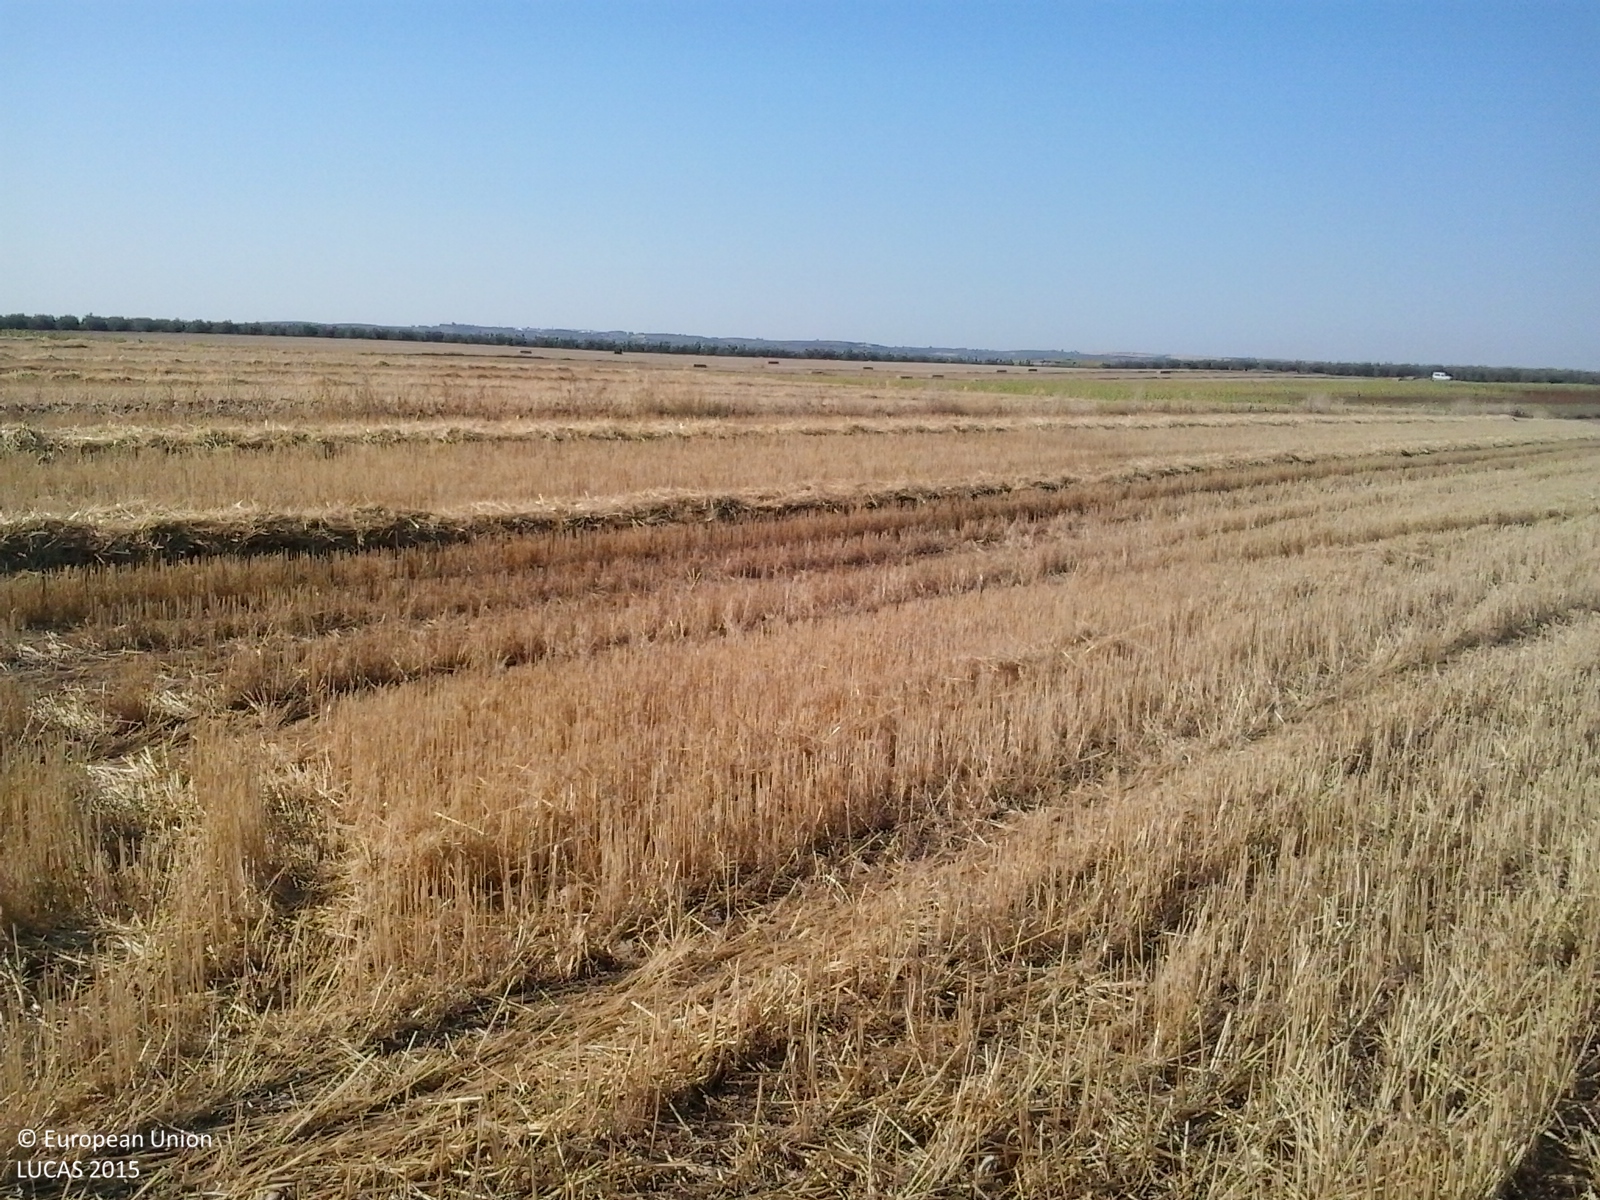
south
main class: Cropland
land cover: Common wheat
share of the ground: < 10 %
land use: Agriculture (excluding fallow land and kitchen gardens)
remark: Harvested field
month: June
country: ES
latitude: 37.4758
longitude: -6.1876
